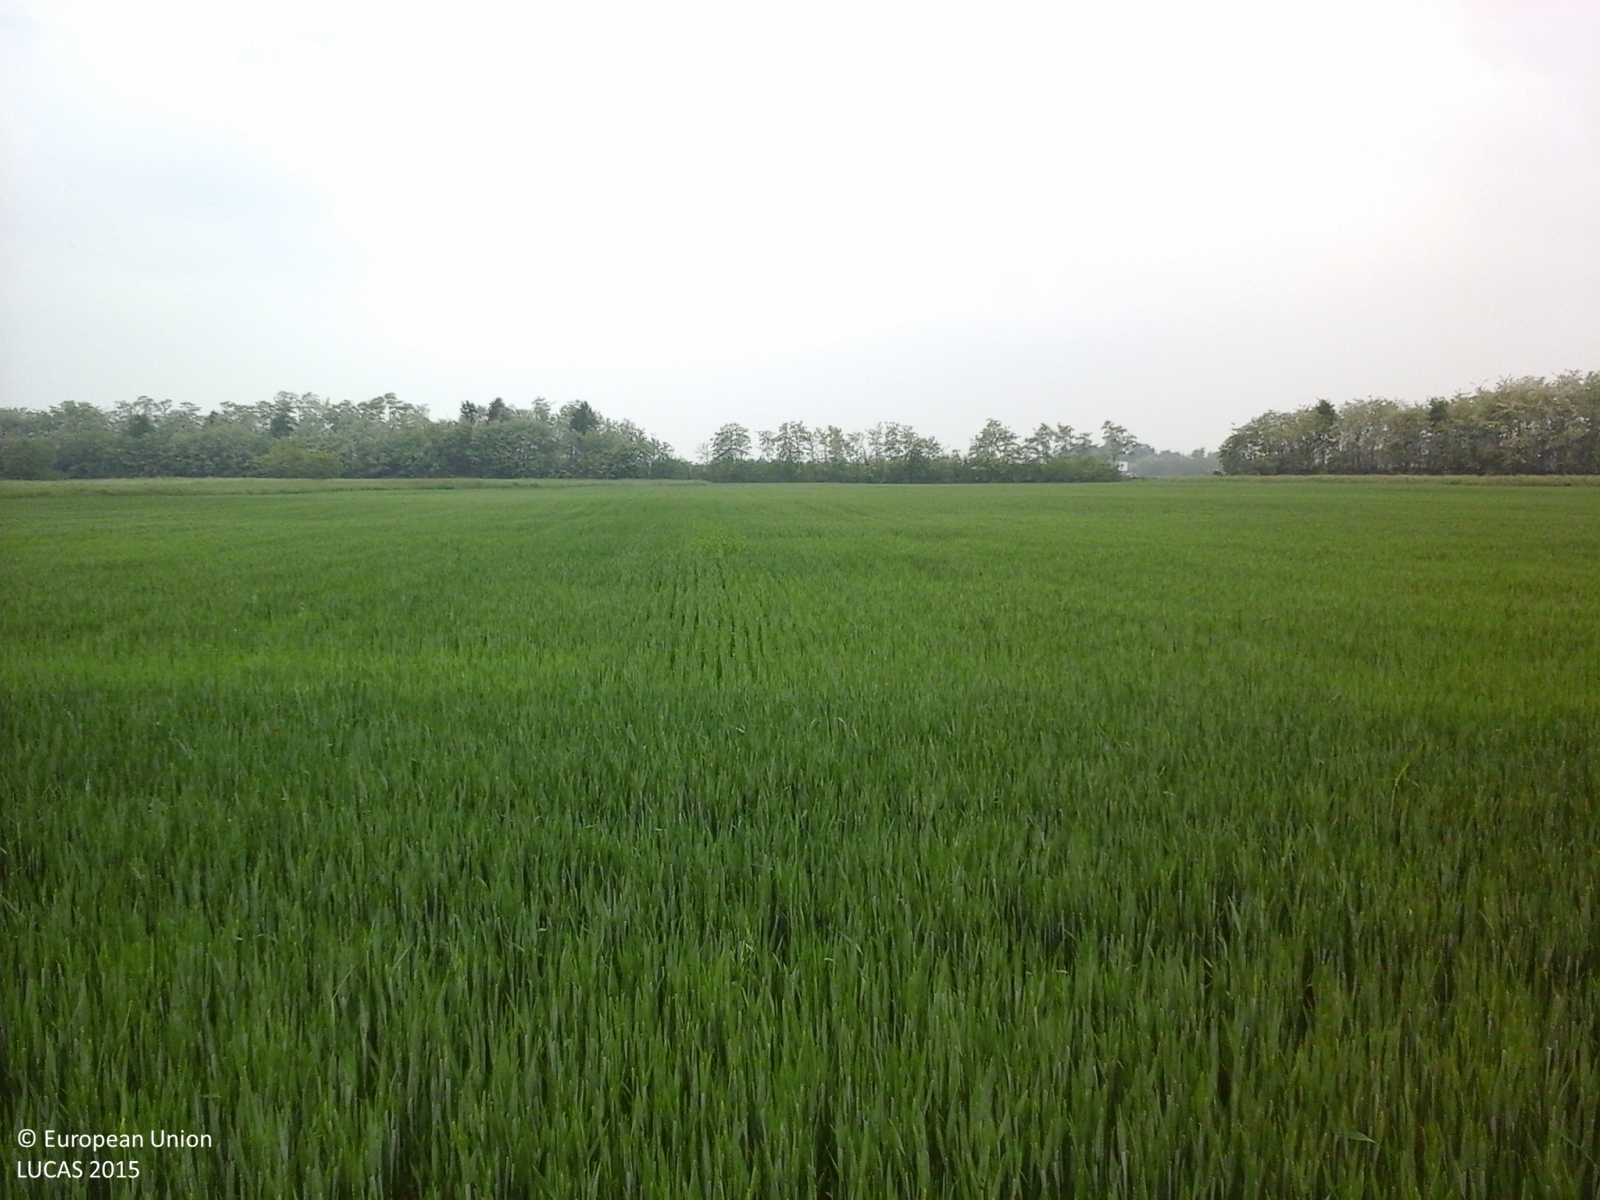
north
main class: Cropland
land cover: Common wheat
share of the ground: > 75 %
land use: Agriculture (excluding fallow land and kitchen gardens)
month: May
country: IT
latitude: 45.5309
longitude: 8.5810
